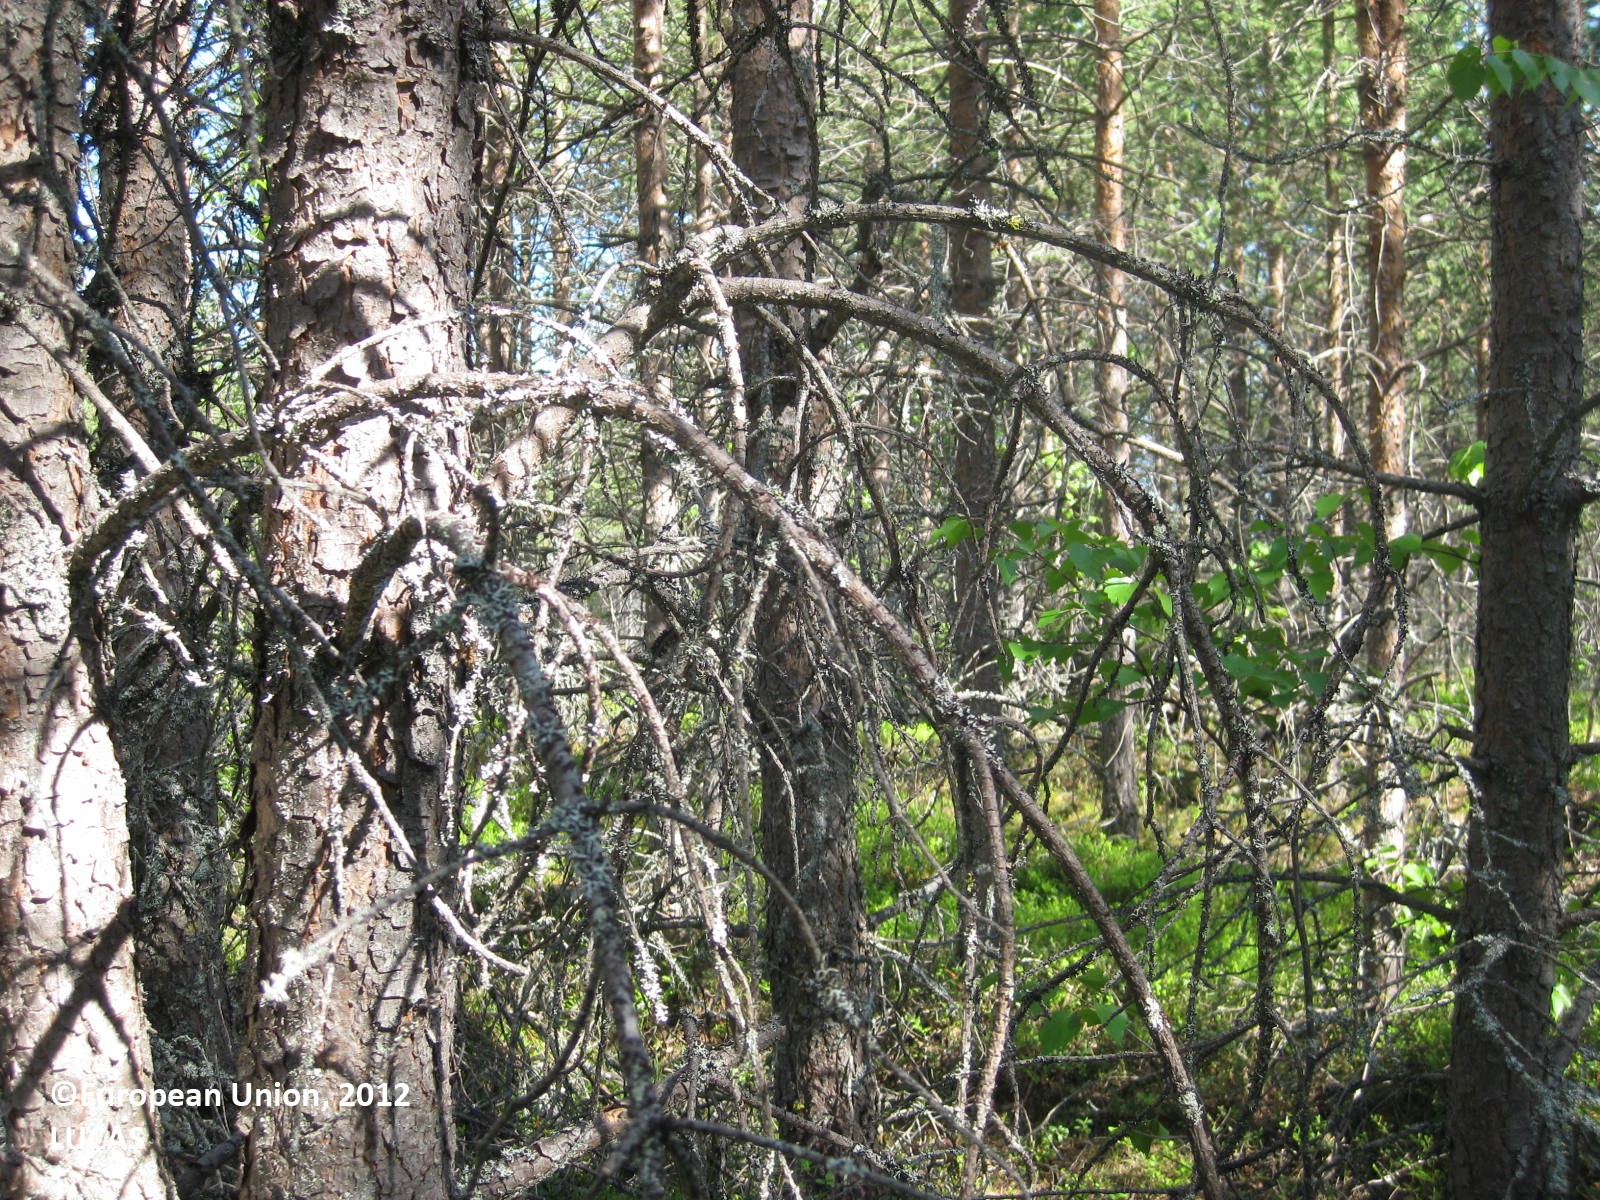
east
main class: Woodland
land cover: Pine dominated coniferous woodland
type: boreal forest
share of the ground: > 75 %
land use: Forestry
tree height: > 5 m
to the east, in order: Pine dominated coniferous woodland; Ditches and canals; Grass margins; Paved roads, cycling and walking lanes; Abandoned hedges; Ditches and canals; Pine dominated coniferous woodland; Ditches and canals; Pine dominated coniferous woodland; Ditches and canals; Pine dominated coniferous woodland; Ditches and canals; Pine dominated coniferous woodland; Ditches and canals; Pine dominated coniferous woodland; Ditches and canals; Pine dominated coniferous woodland; Ditches and canals; Pine dominated coniferous woodland; Ditches and canals; Pine dominated coniferous woodland; Ditches and canals; Pine dominated coniferous woodland; Ditches and canals; Conifer hedges; Ditches and canals; Pine dominated coniferous woodland; Shrubland with sparse tree cover; Tracks; Shrubland with sparse tree cover; Tracks; Shrubland with sparse tree cover; Pine dominated coniferous woodland; Conifer hedges; Paved roads, cycling and walking lanes; Pine dominated coniferous woodland
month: June
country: FI
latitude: 65.0340
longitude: 28.8010
